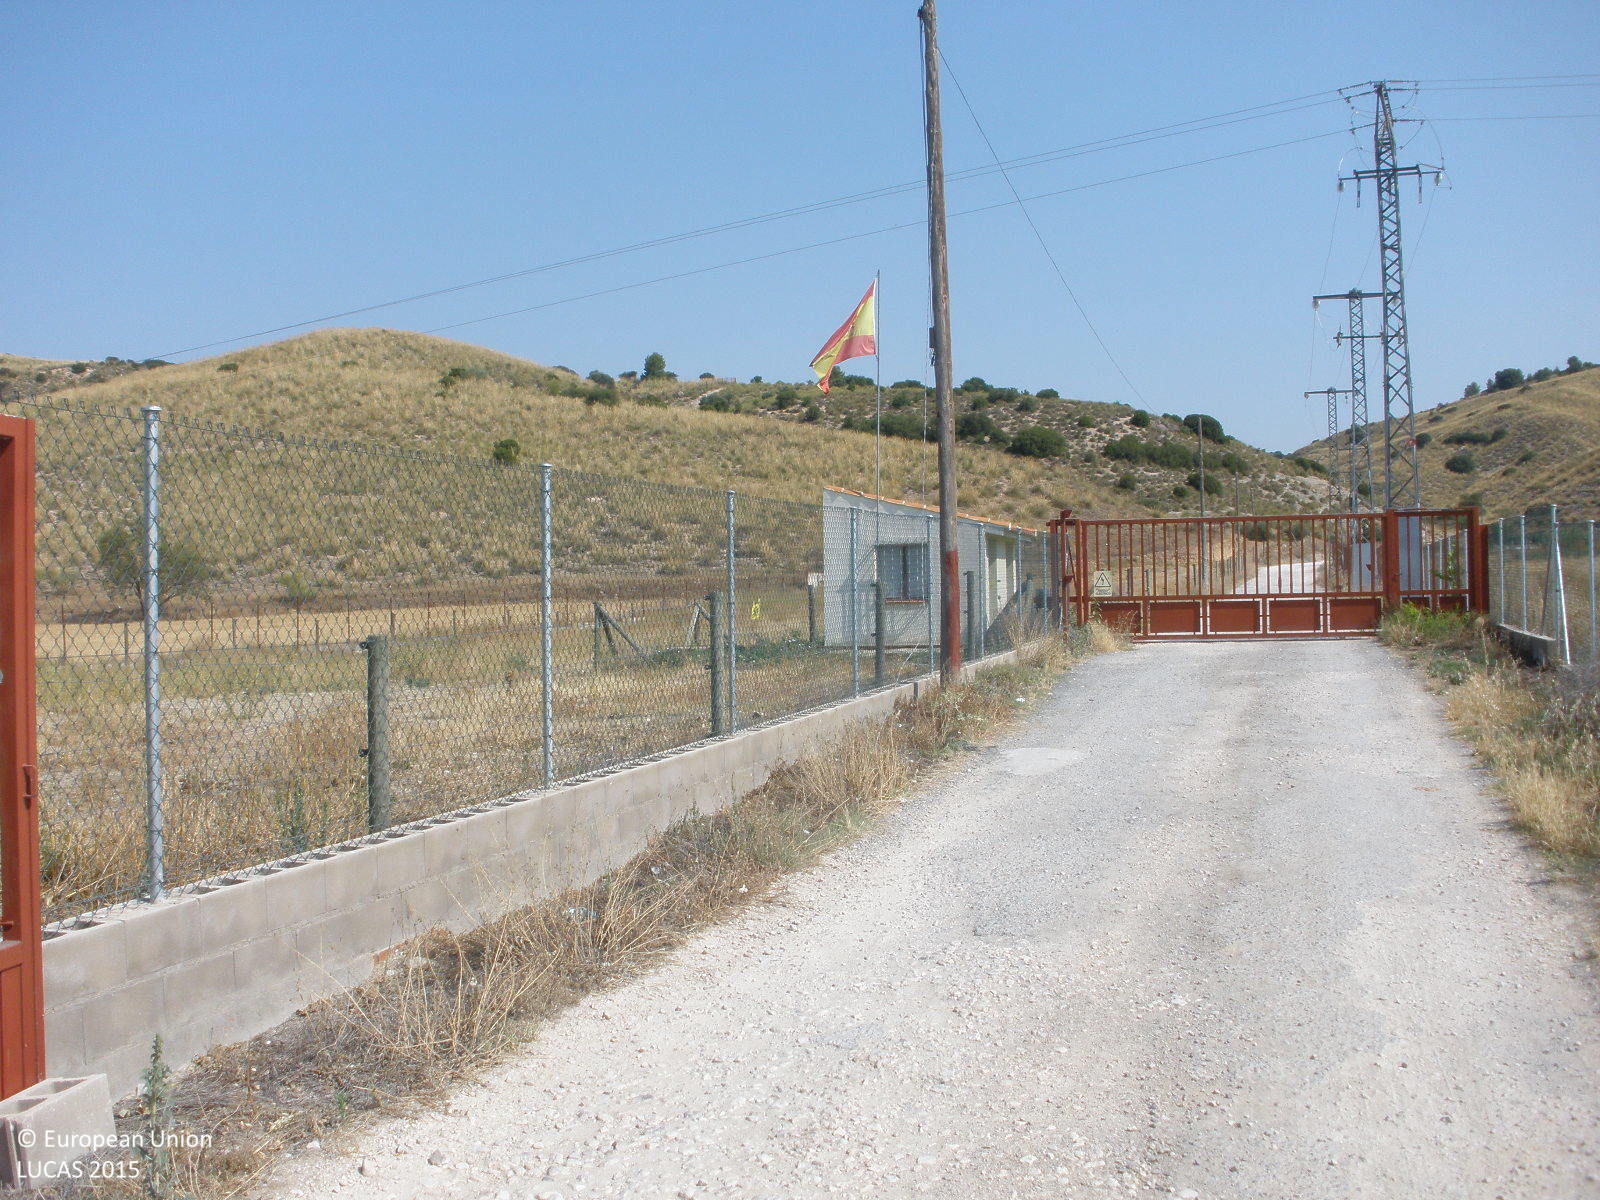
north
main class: Shrubland
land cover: Shrubland with sparse tree cover
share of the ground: 50 - 75 %
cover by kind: herbaceous plants 50 %, shrubs 45 %, broadleaved forest trees 5 %
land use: Semi-natural and natural areas not in use
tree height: < 5 m
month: June
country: ES
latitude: 40.2571
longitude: -3.2808
